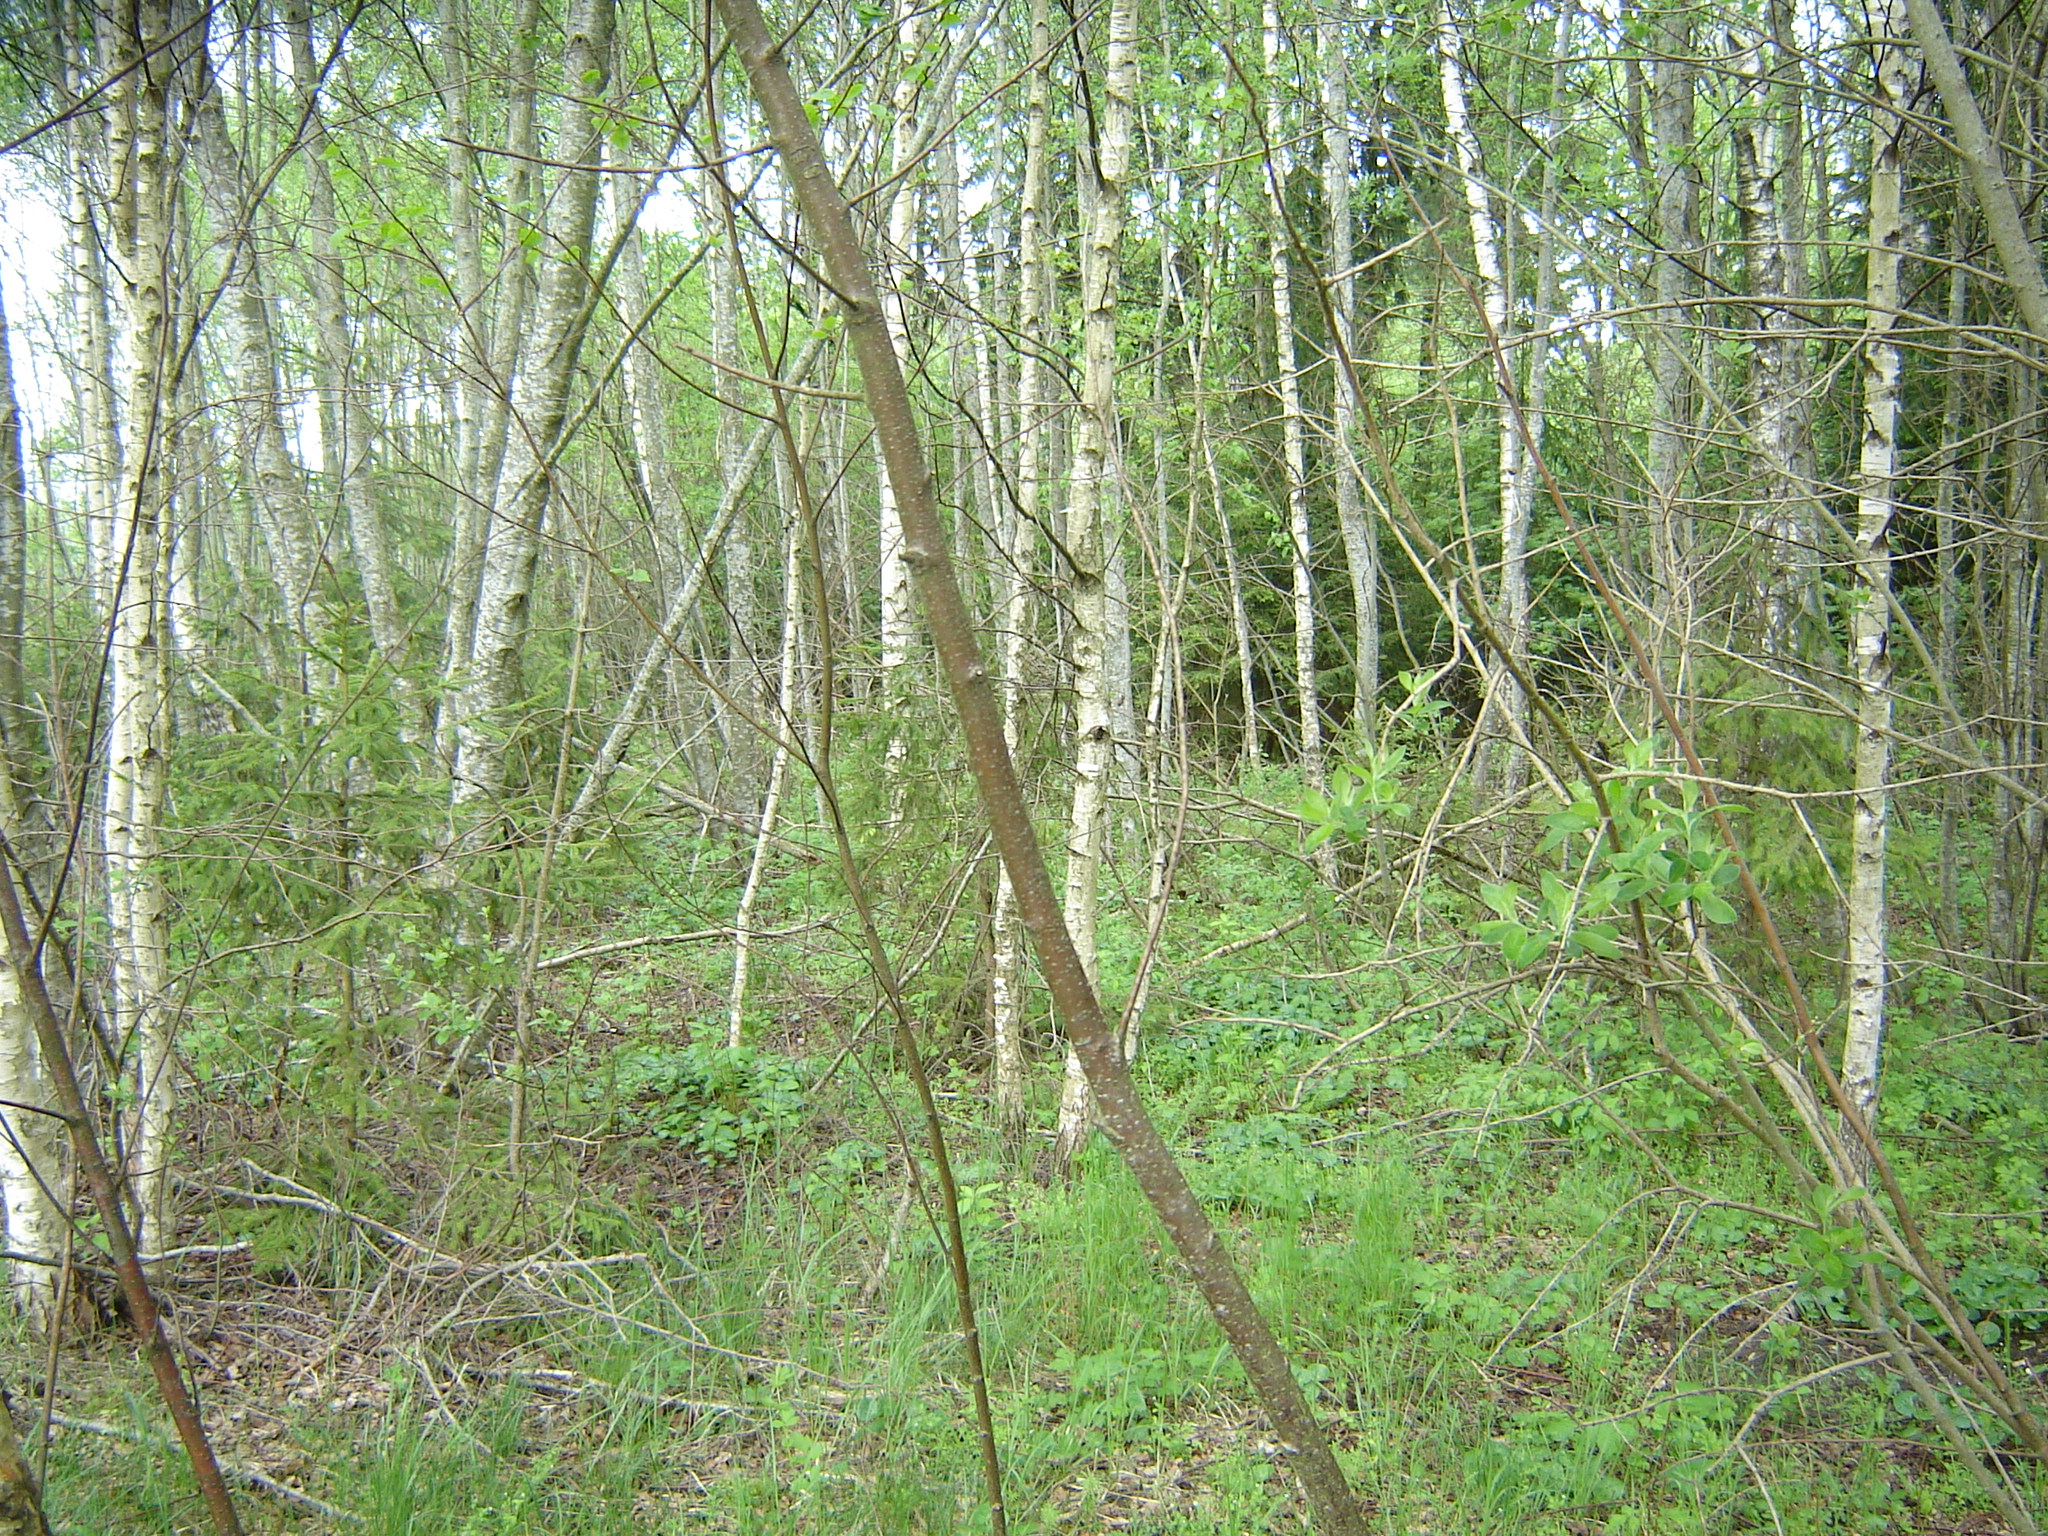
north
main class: Woodland
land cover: Broadleaved woodland
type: non-riverine alder, birch or aspen forest
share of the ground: > 75 %
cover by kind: broadleaved forest trees 80 %, herbaceous plants 10 %, coniferous forest trees 5 %, shrubs 5 %
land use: Forestry
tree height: > 5 m
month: May
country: LT
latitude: 56.1008
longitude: 25.3425
